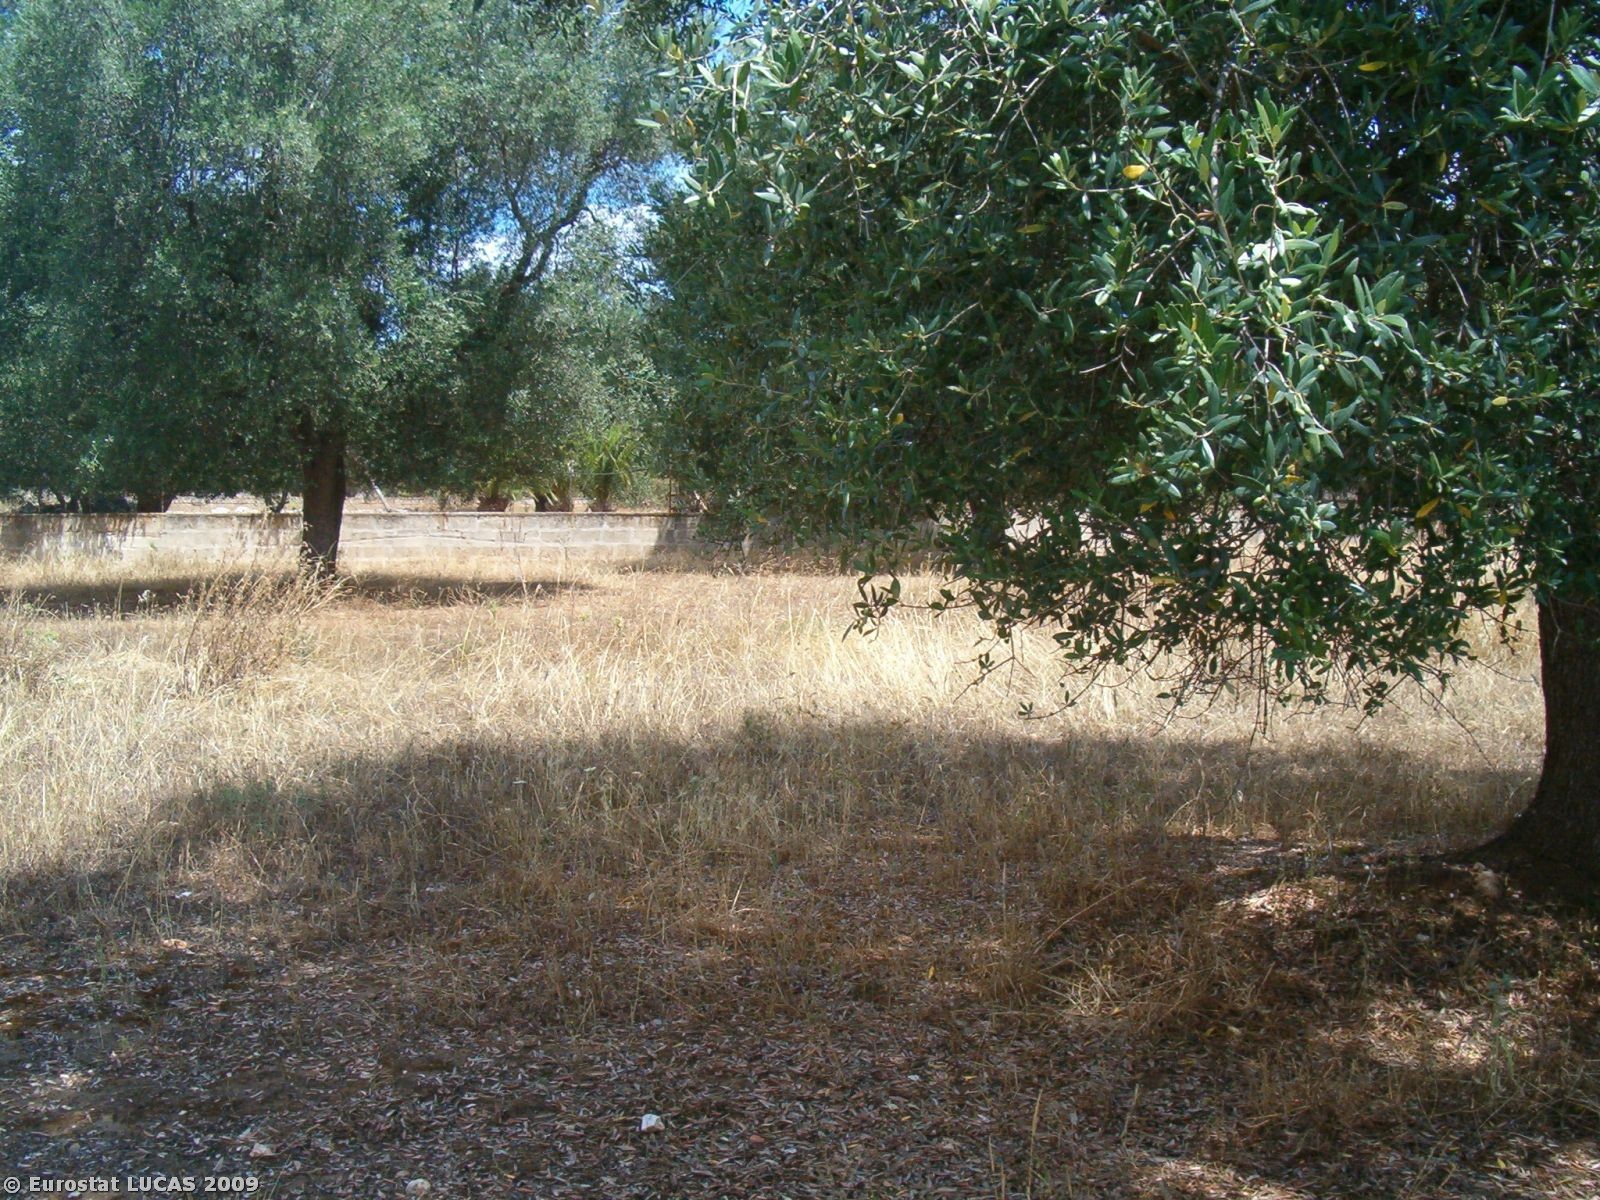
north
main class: Cropland
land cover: Olive groves
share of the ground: 50 - 75 %
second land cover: Spontaneously vegetated surfaces
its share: > 75 %
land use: Agriculture (excluding fallow land and kitchen gardens)
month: June
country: IT
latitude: 40.5037
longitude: 17.5399
